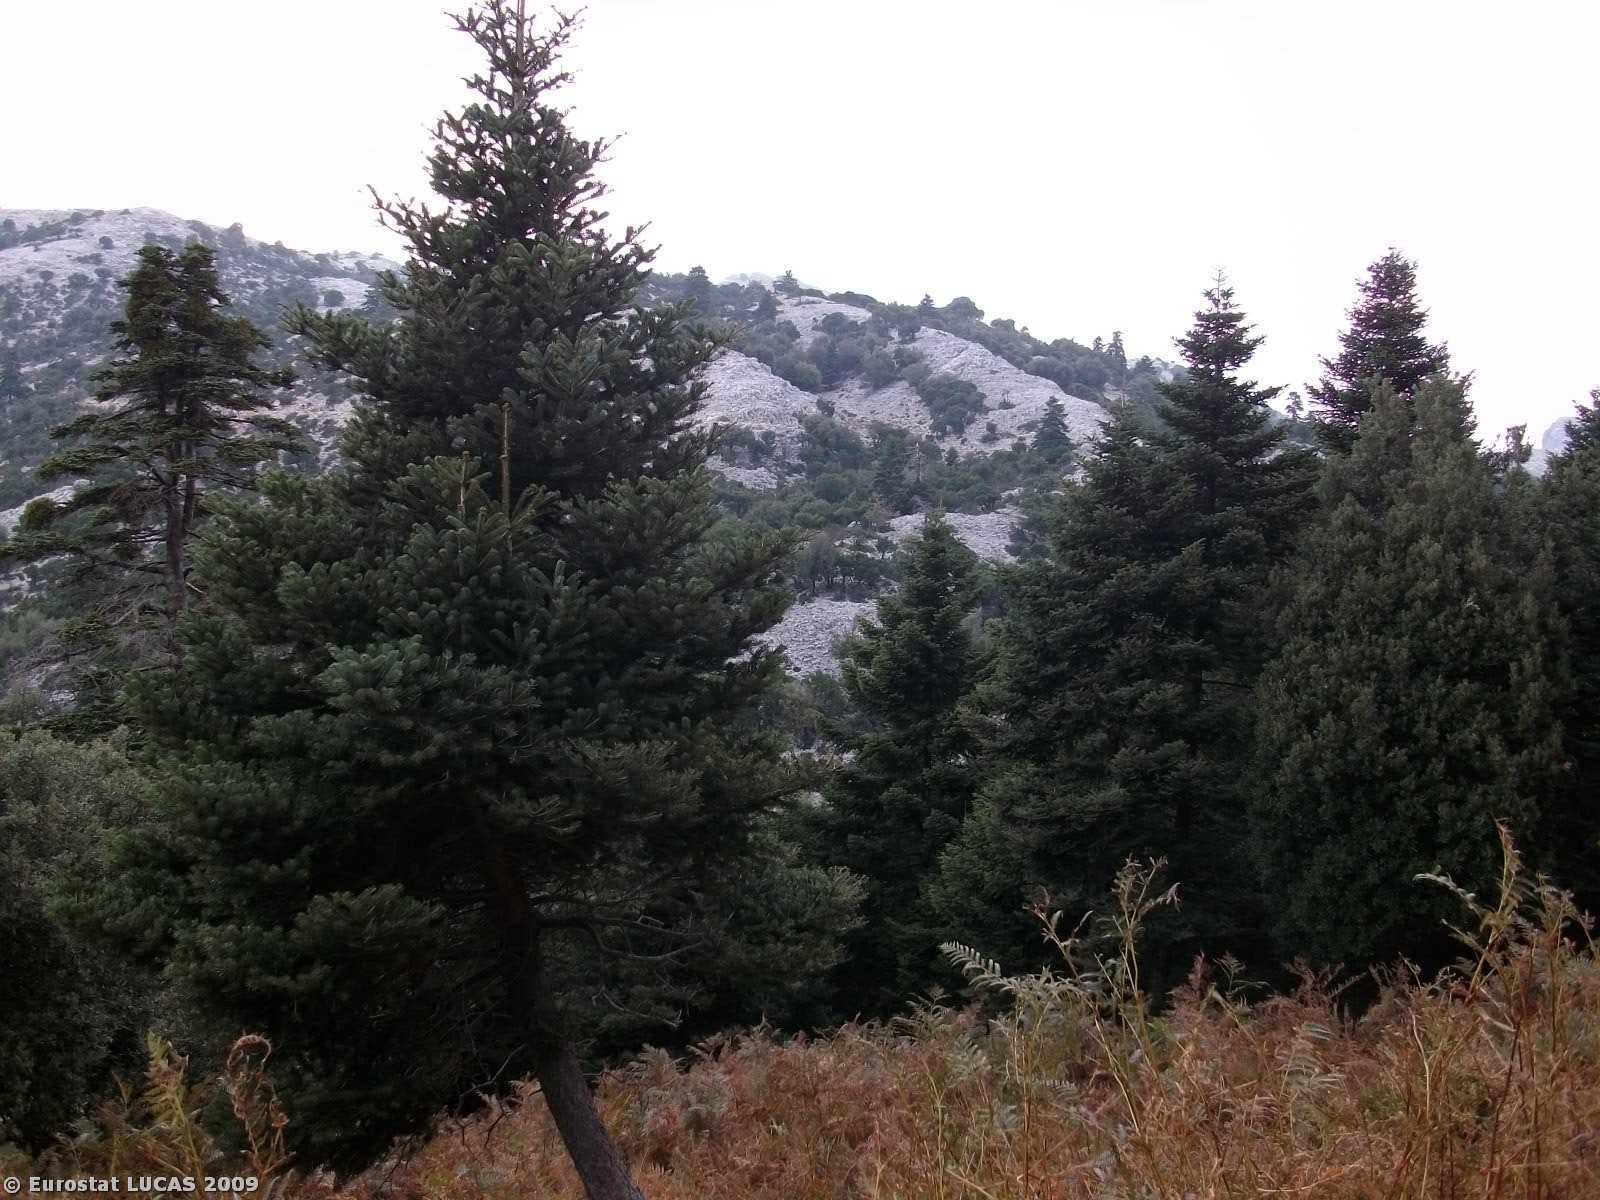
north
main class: Woodland
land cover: Coniferous woodland
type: coniferous forest of the mediterranean region
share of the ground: > 75 %
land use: Forestry
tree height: > 5 m
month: October
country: GR
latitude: 38.6527
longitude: 24.0007
